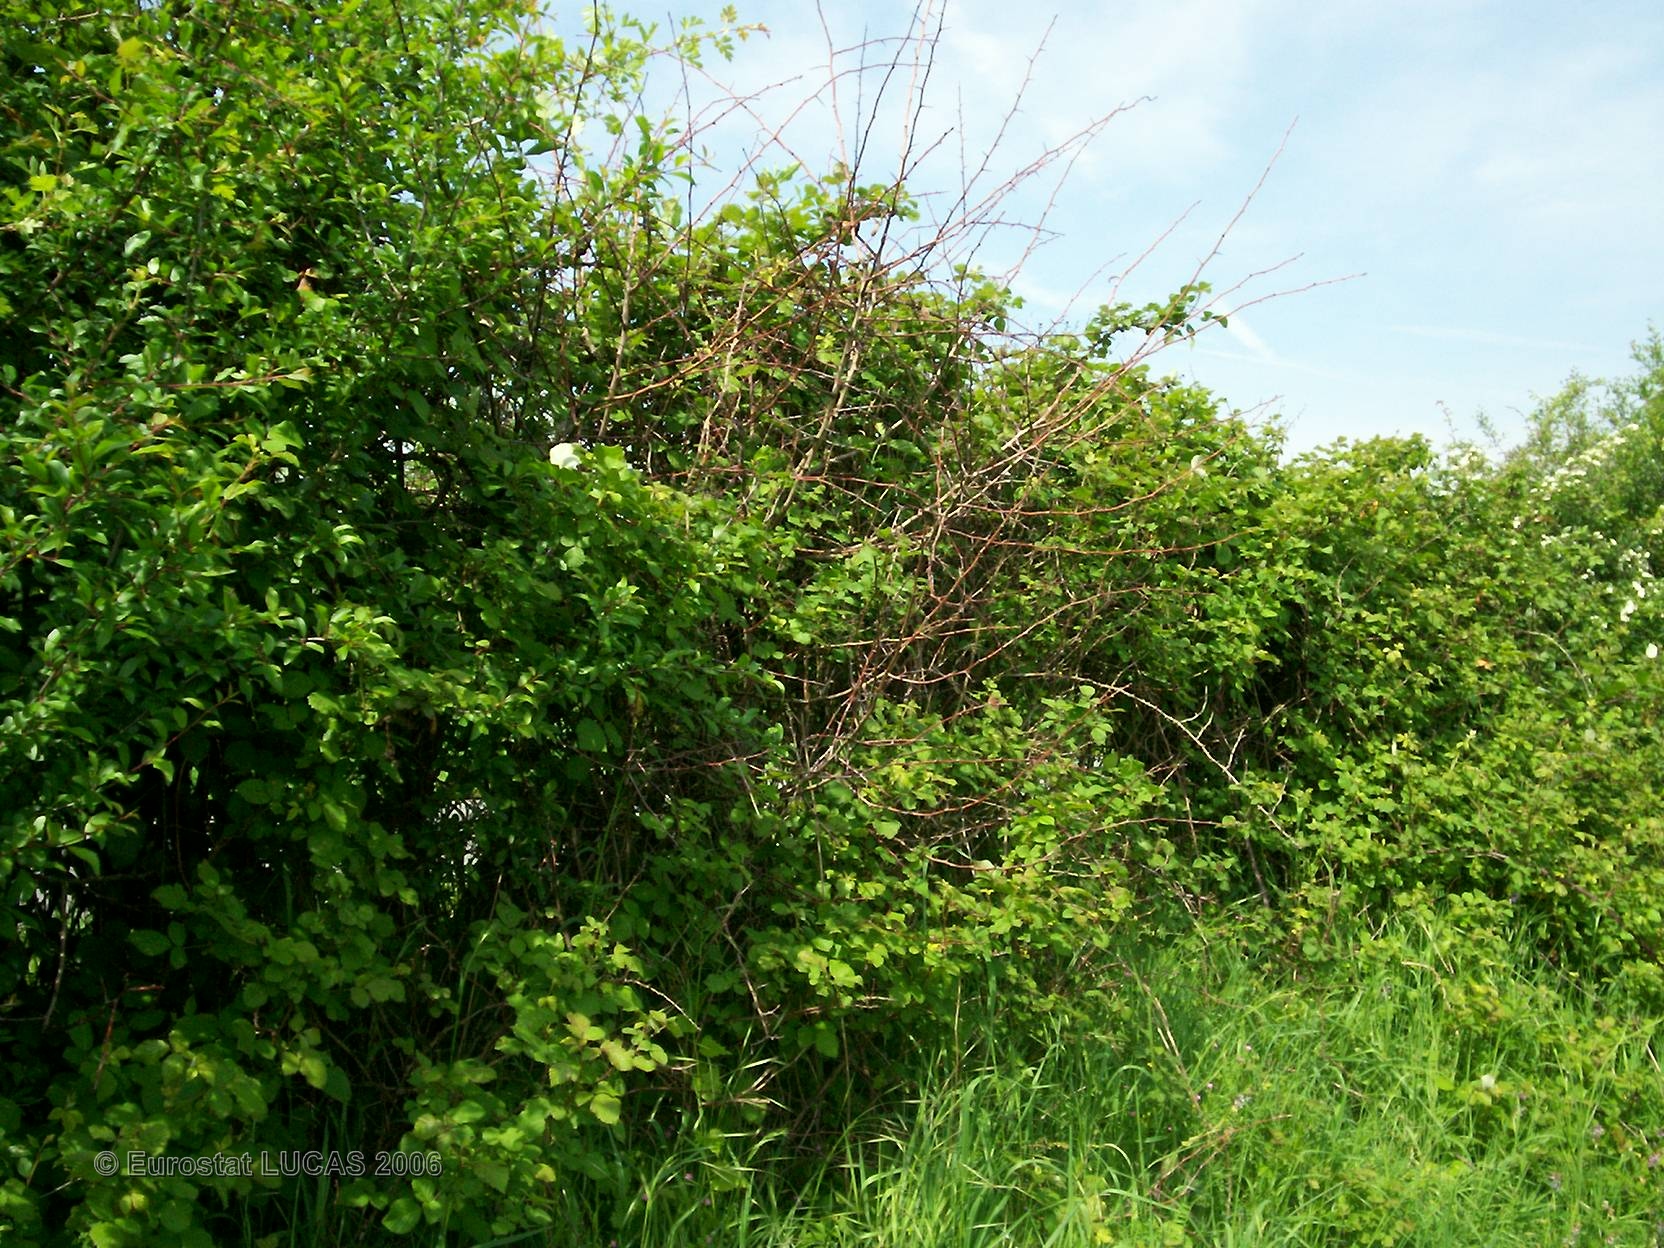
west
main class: Grassland
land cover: Grassland without tree/shrub cover
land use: Agriculture (excluding fallow land and kitchen gardens)
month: May
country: FR
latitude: 46.5232
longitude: -0.3100
